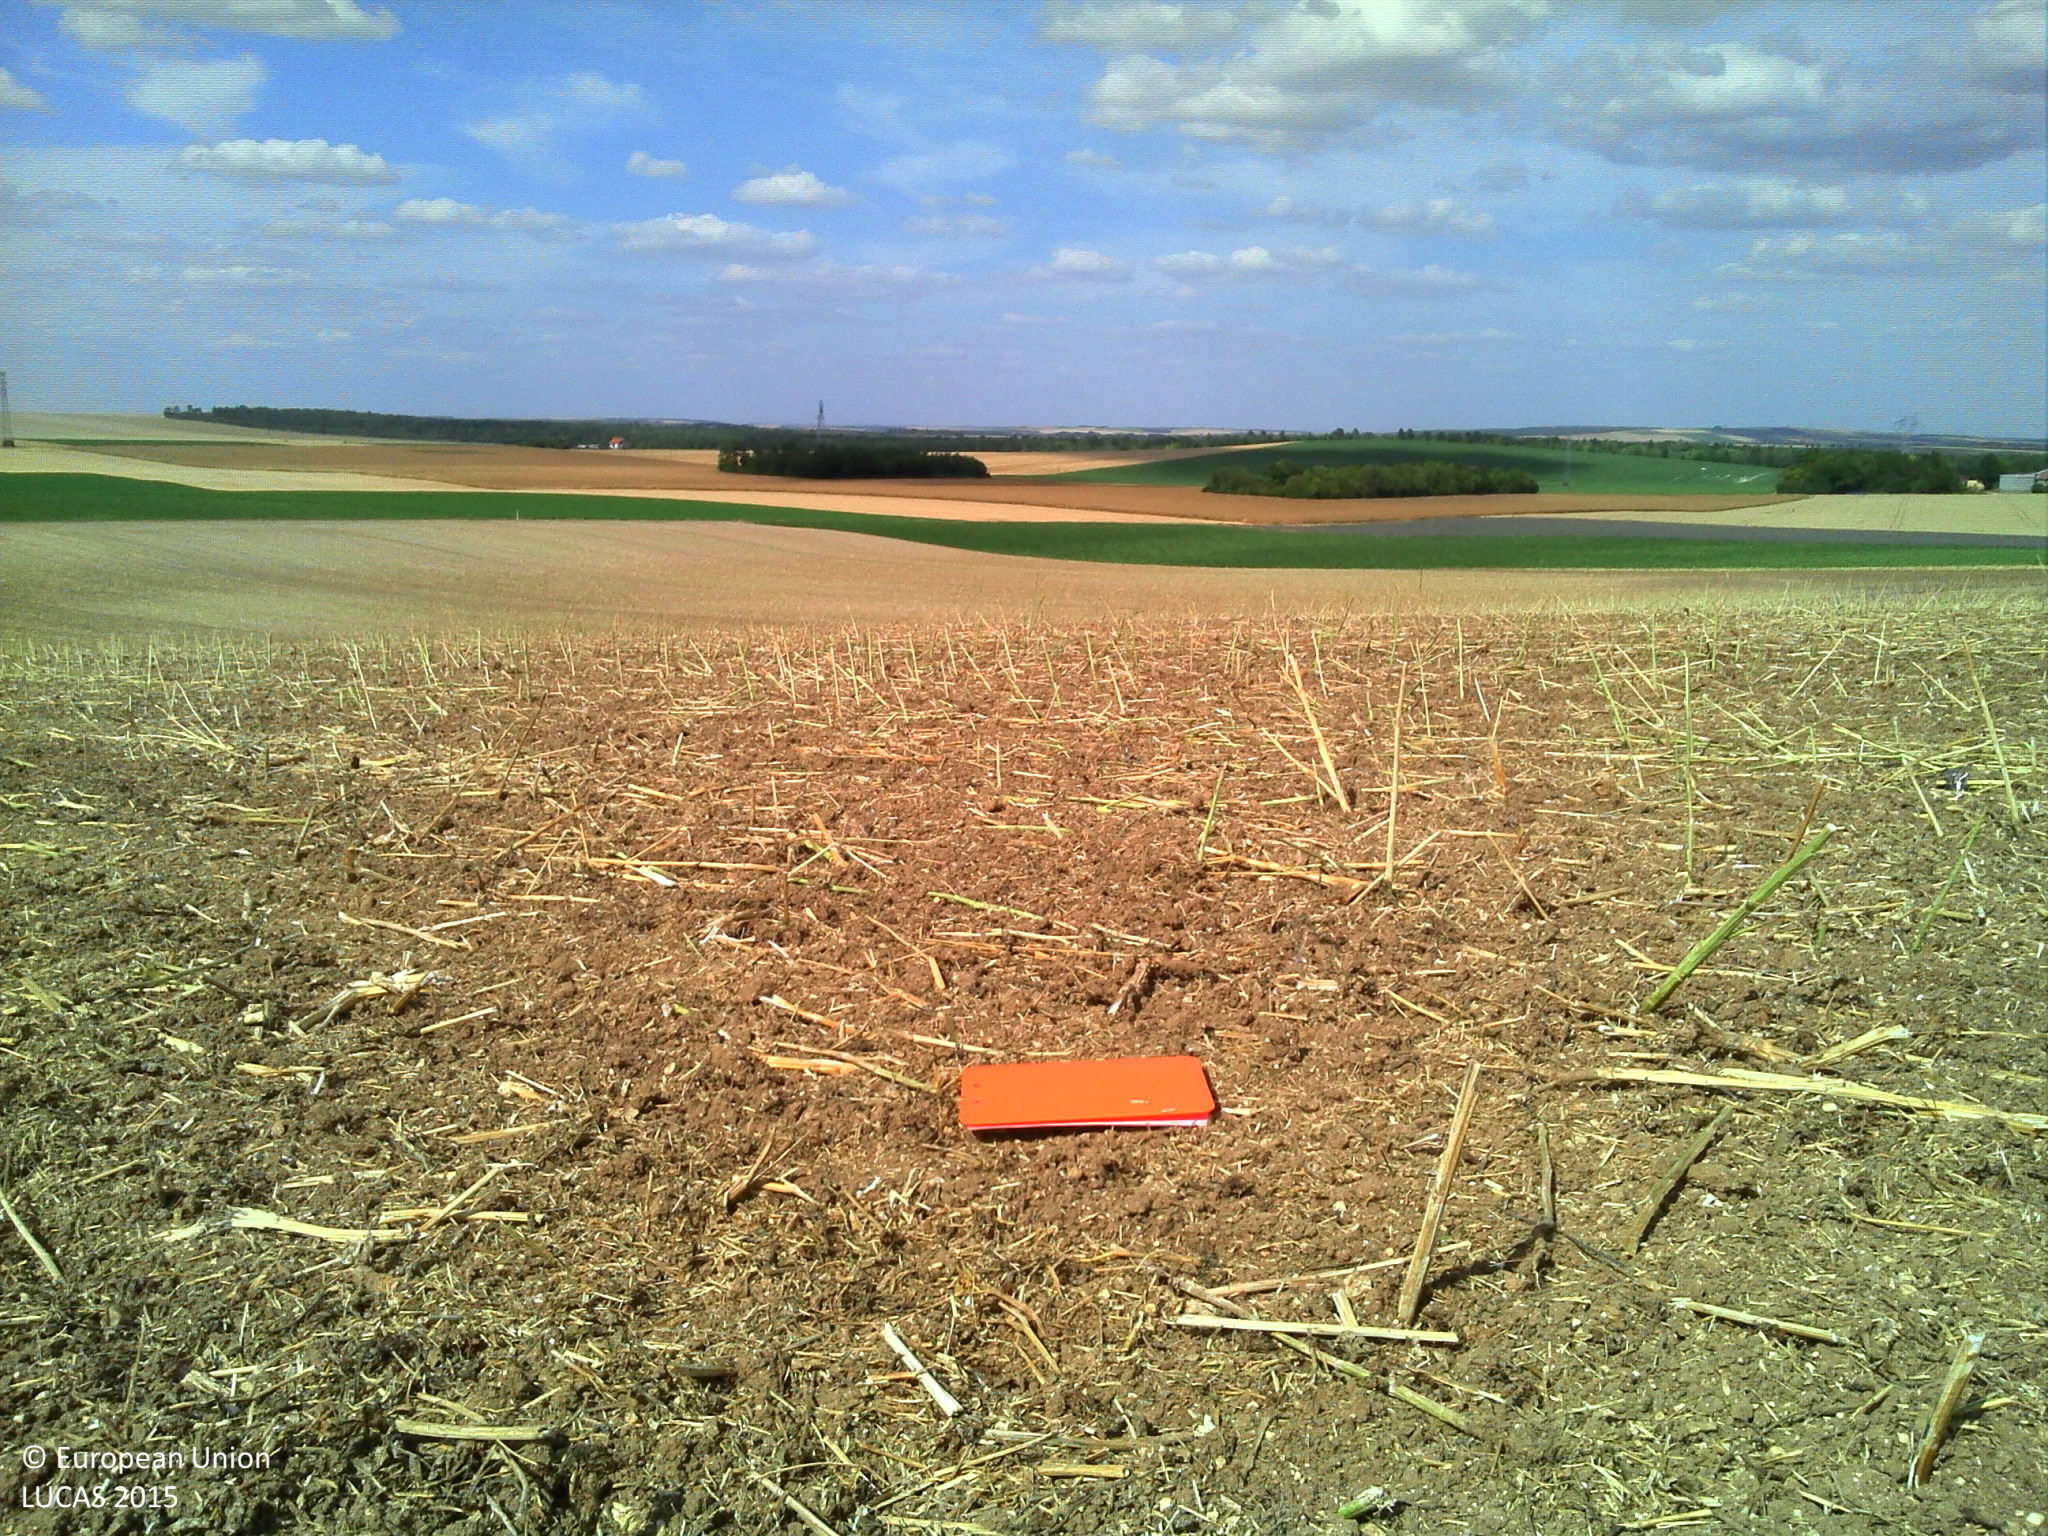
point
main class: Cropland
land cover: Rape and turnip rape
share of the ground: > 75 %
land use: Agriculture (excluding fallow land and kitchen gardens)
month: July
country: FR
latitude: 49.2604
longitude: 4.1831
